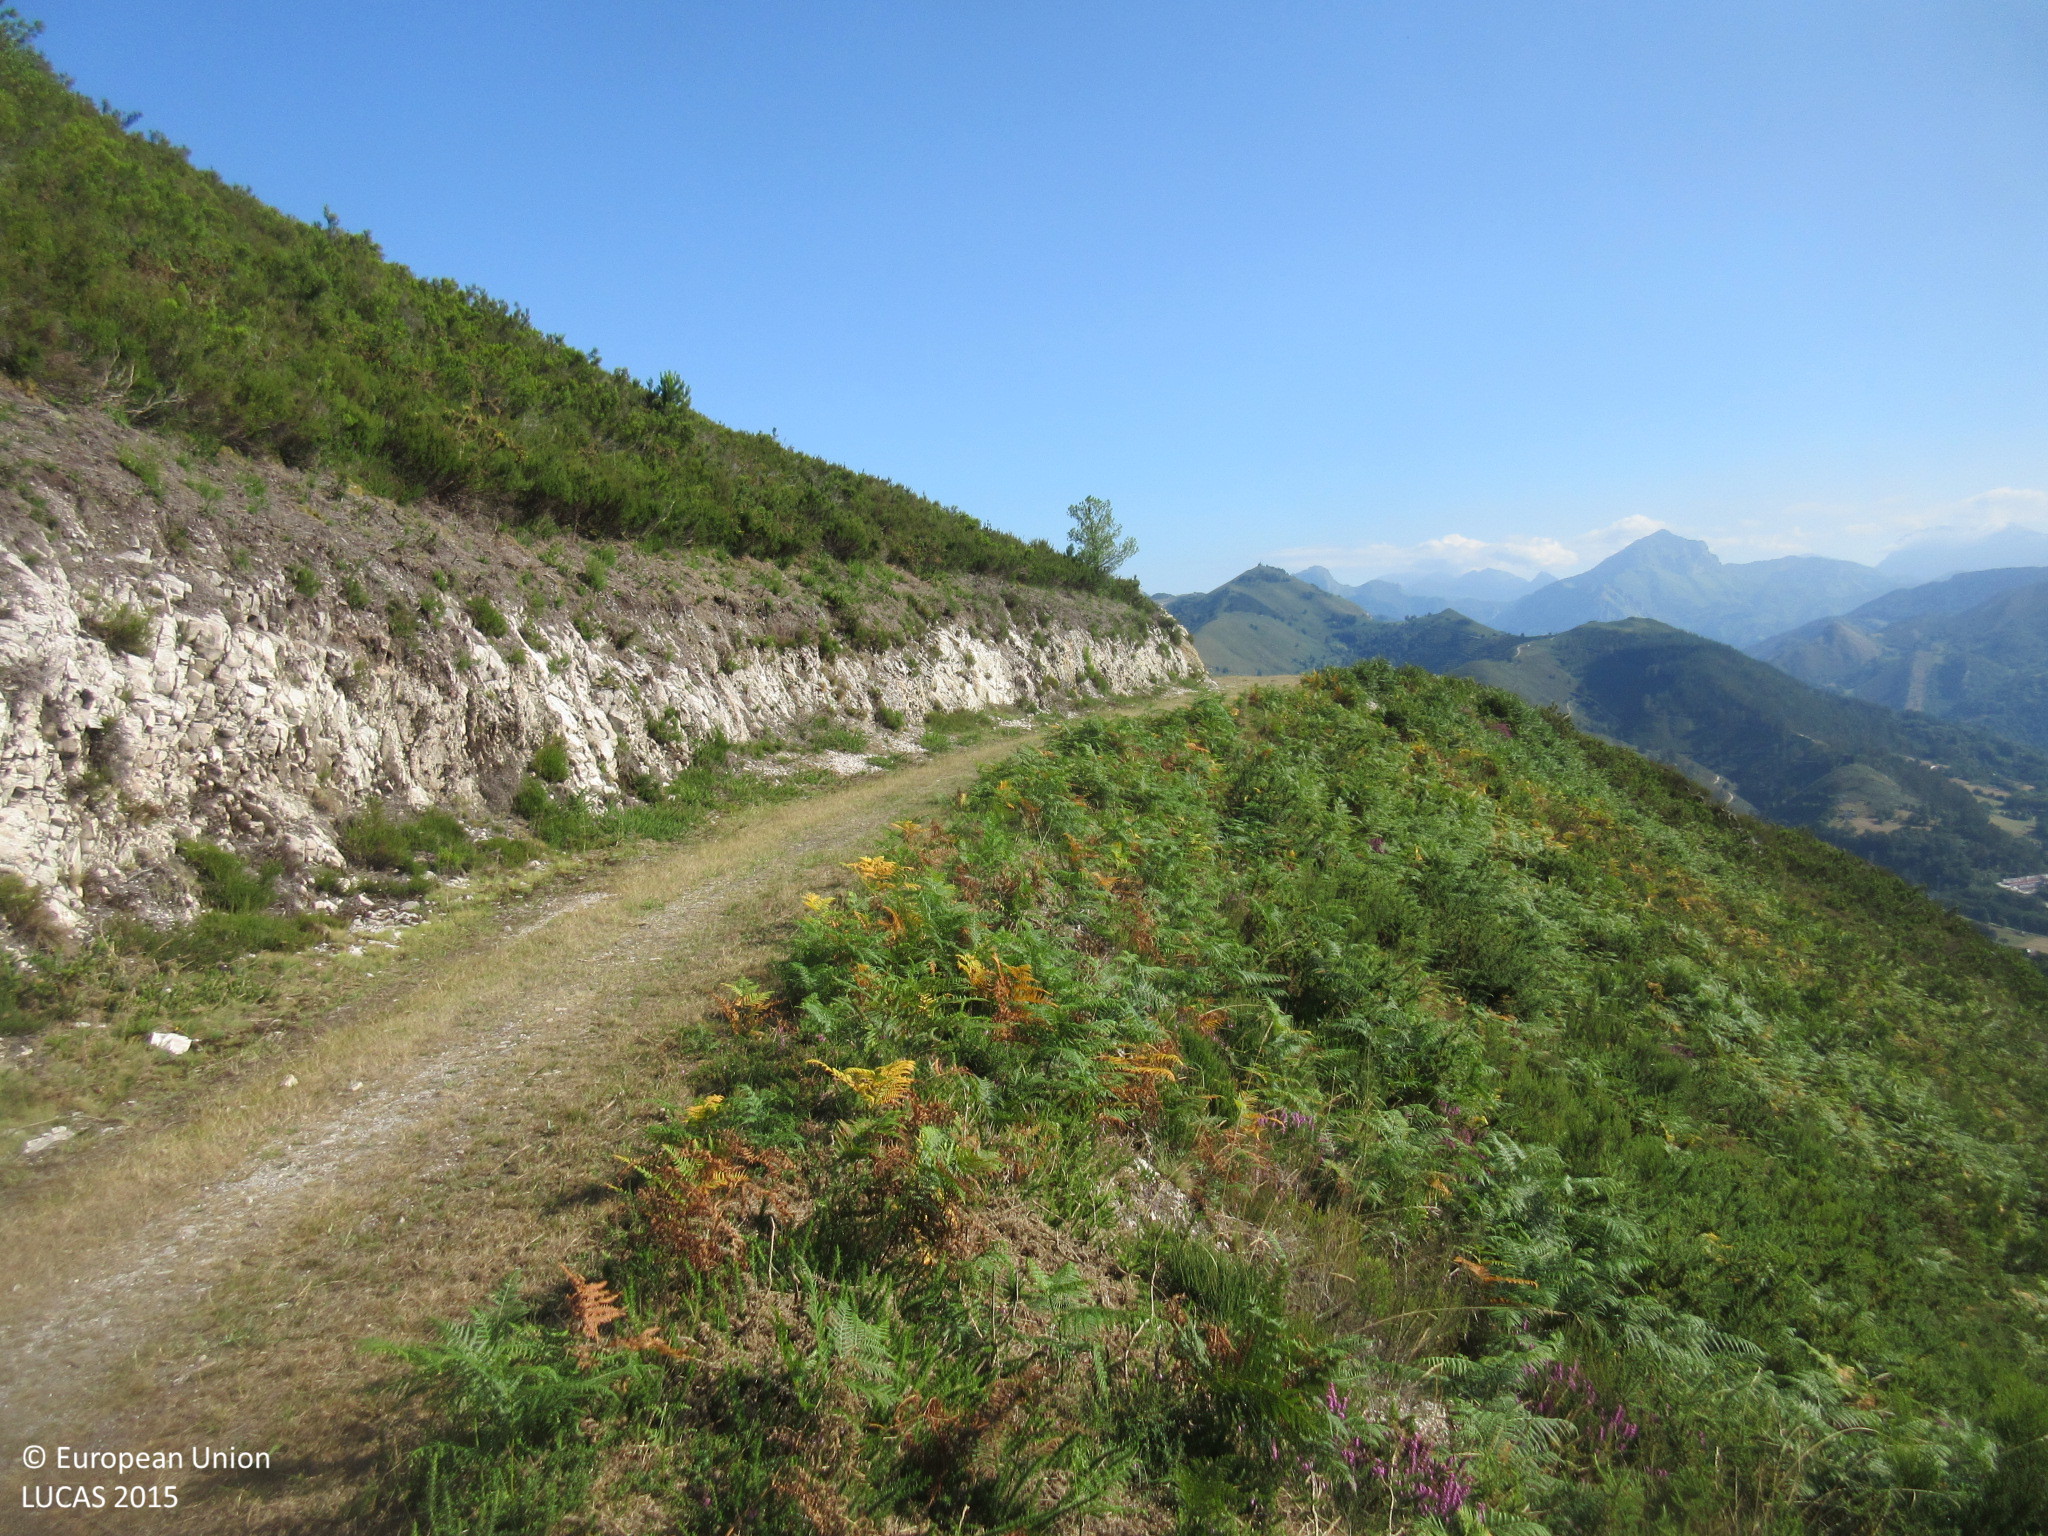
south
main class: Shrubland
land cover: Shrubland without tree cover
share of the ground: > 75 %
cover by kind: shrubs 100 %
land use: Agriculture (excluding fallow land and kitchen gardens)
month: July
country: ES
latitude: 43.3642
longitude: -5.1143
